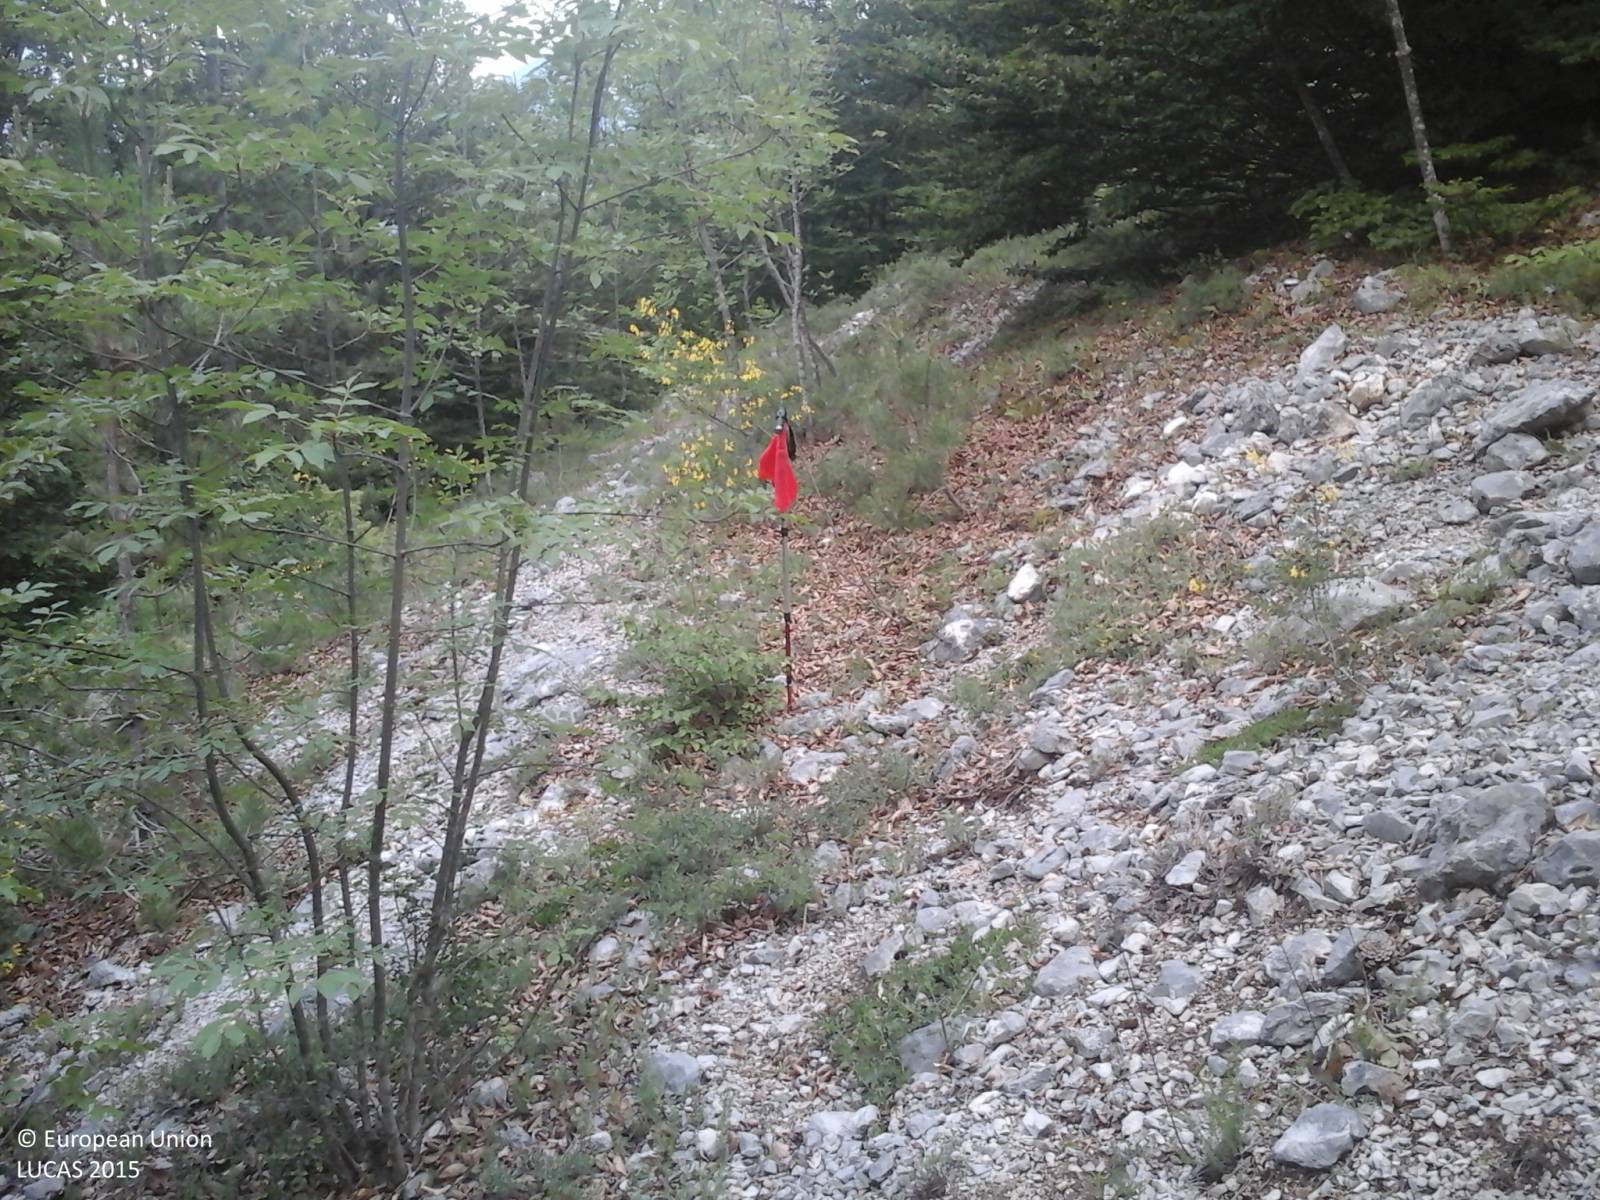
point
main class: Woodland
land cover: Broadleaved woodland
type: mountainous beech forest
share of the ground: > 75 %
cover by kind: broadleaved forest trees 80 %, unconsolidated bare surface 10 %, coniferous forest trees 5 %, shrubs 5 %
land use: Semi-natural and natural areas not in use
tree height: > 5 m
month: June
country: IT
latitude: 41.8919
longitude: 13.3987
